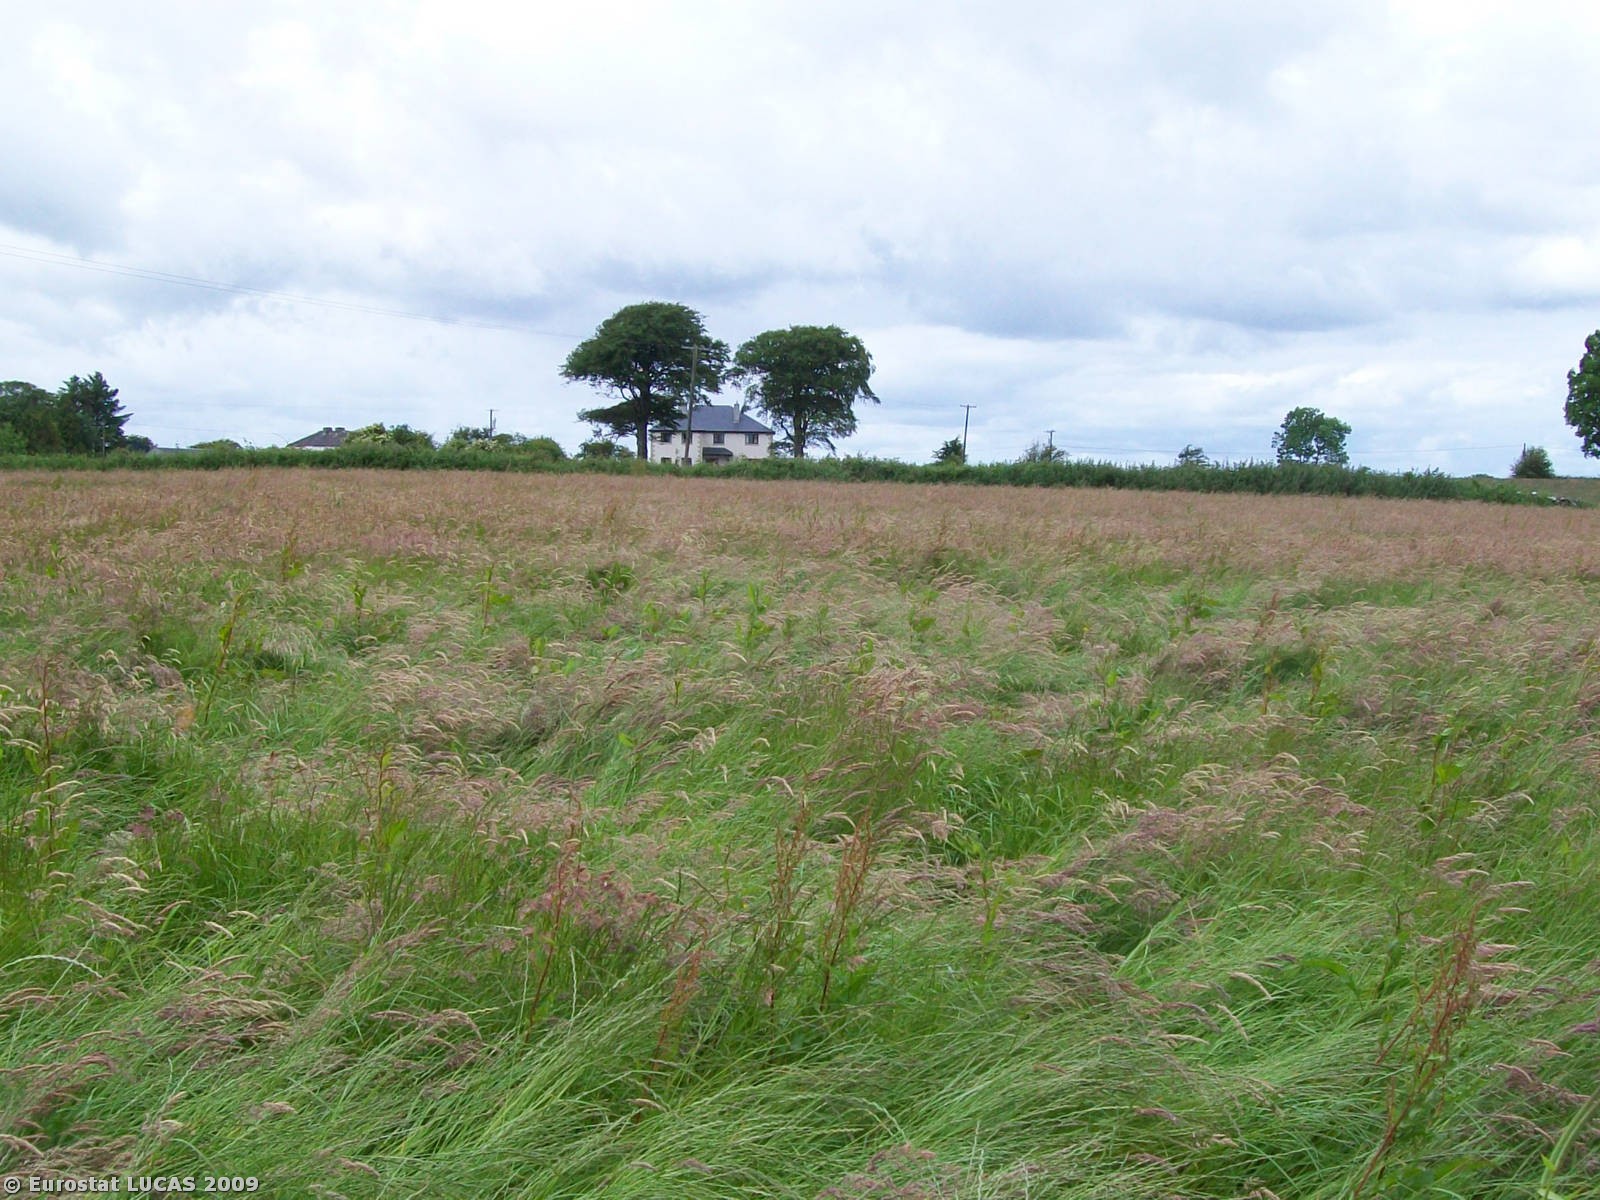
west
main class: Grassland
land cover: Grassland without tree/shrub cover
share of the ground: > 75 %
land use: Agriculture (excluding fallow land and kitchen gardens)
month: June
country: IE
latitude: 53.3838
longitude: -8.8336
